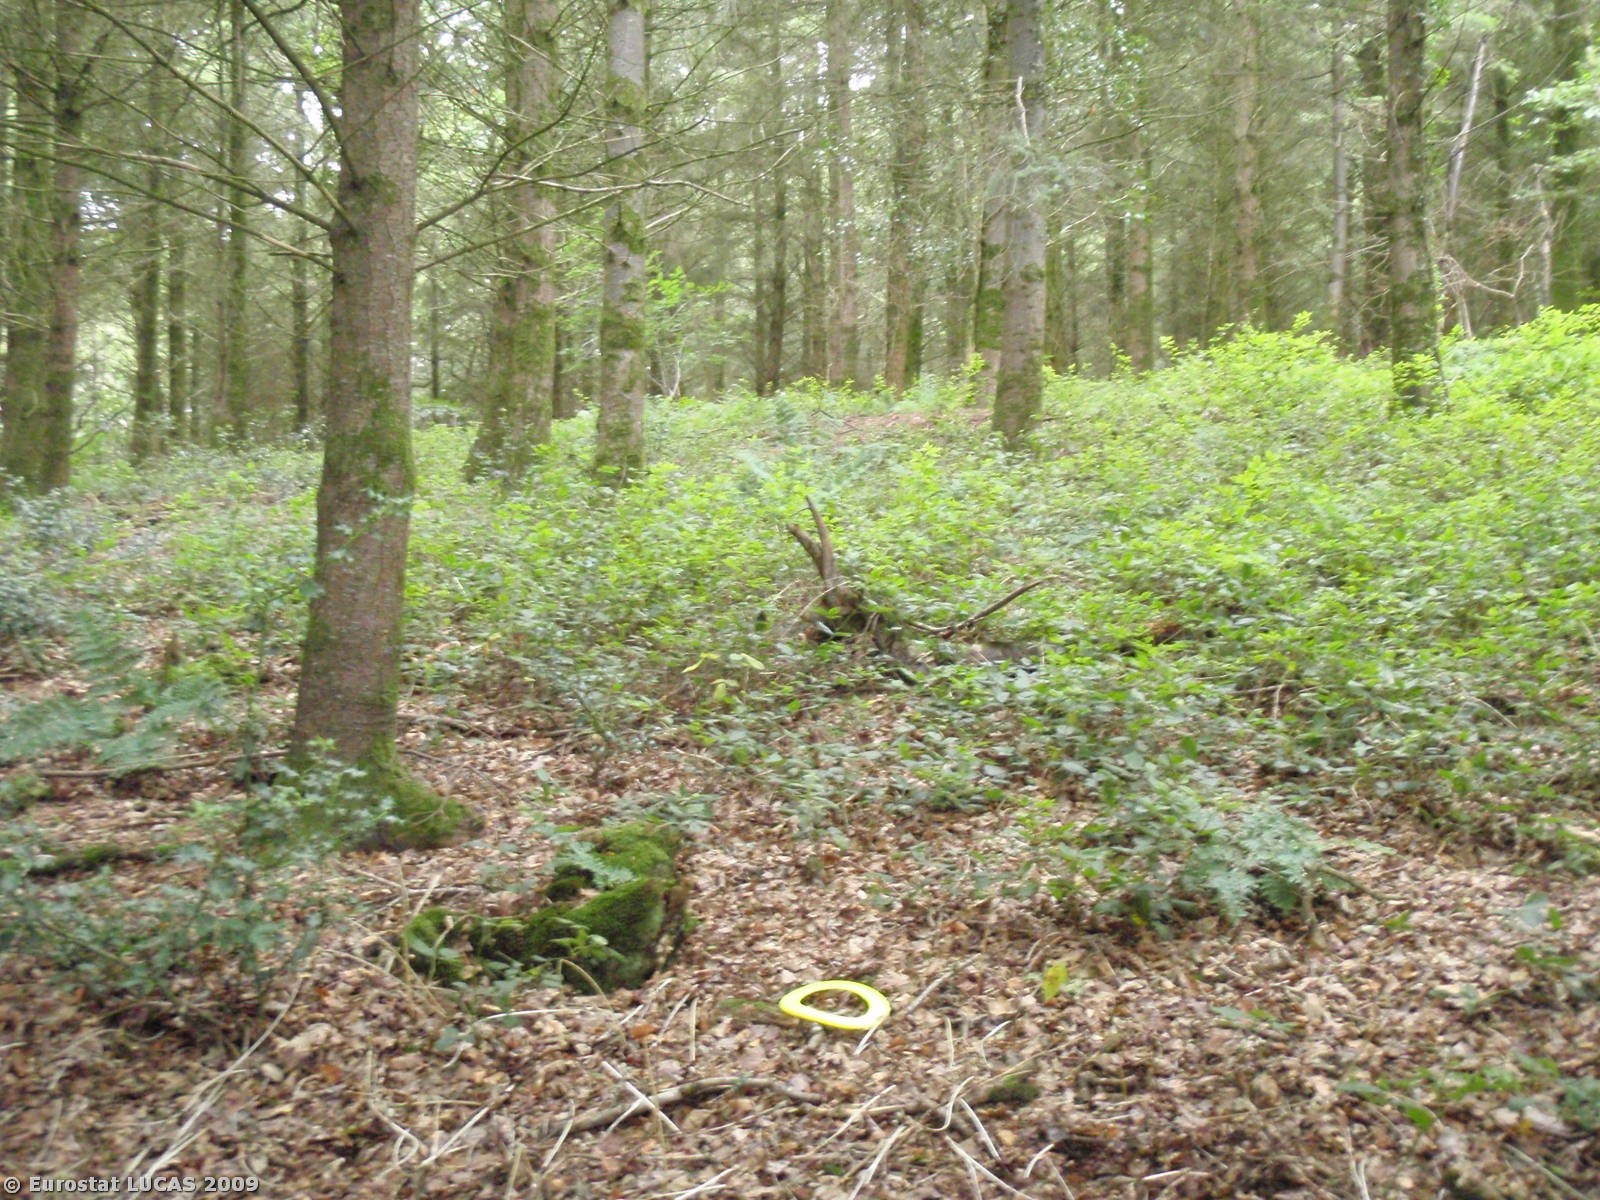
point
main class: Woodland
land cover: Coniferous woodland
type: plantations and self-sown exotic forest
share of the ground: > 75 %
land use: Forestry
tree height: > 5 m
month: August
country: GB
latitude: 50.7296
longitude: -4.3683
